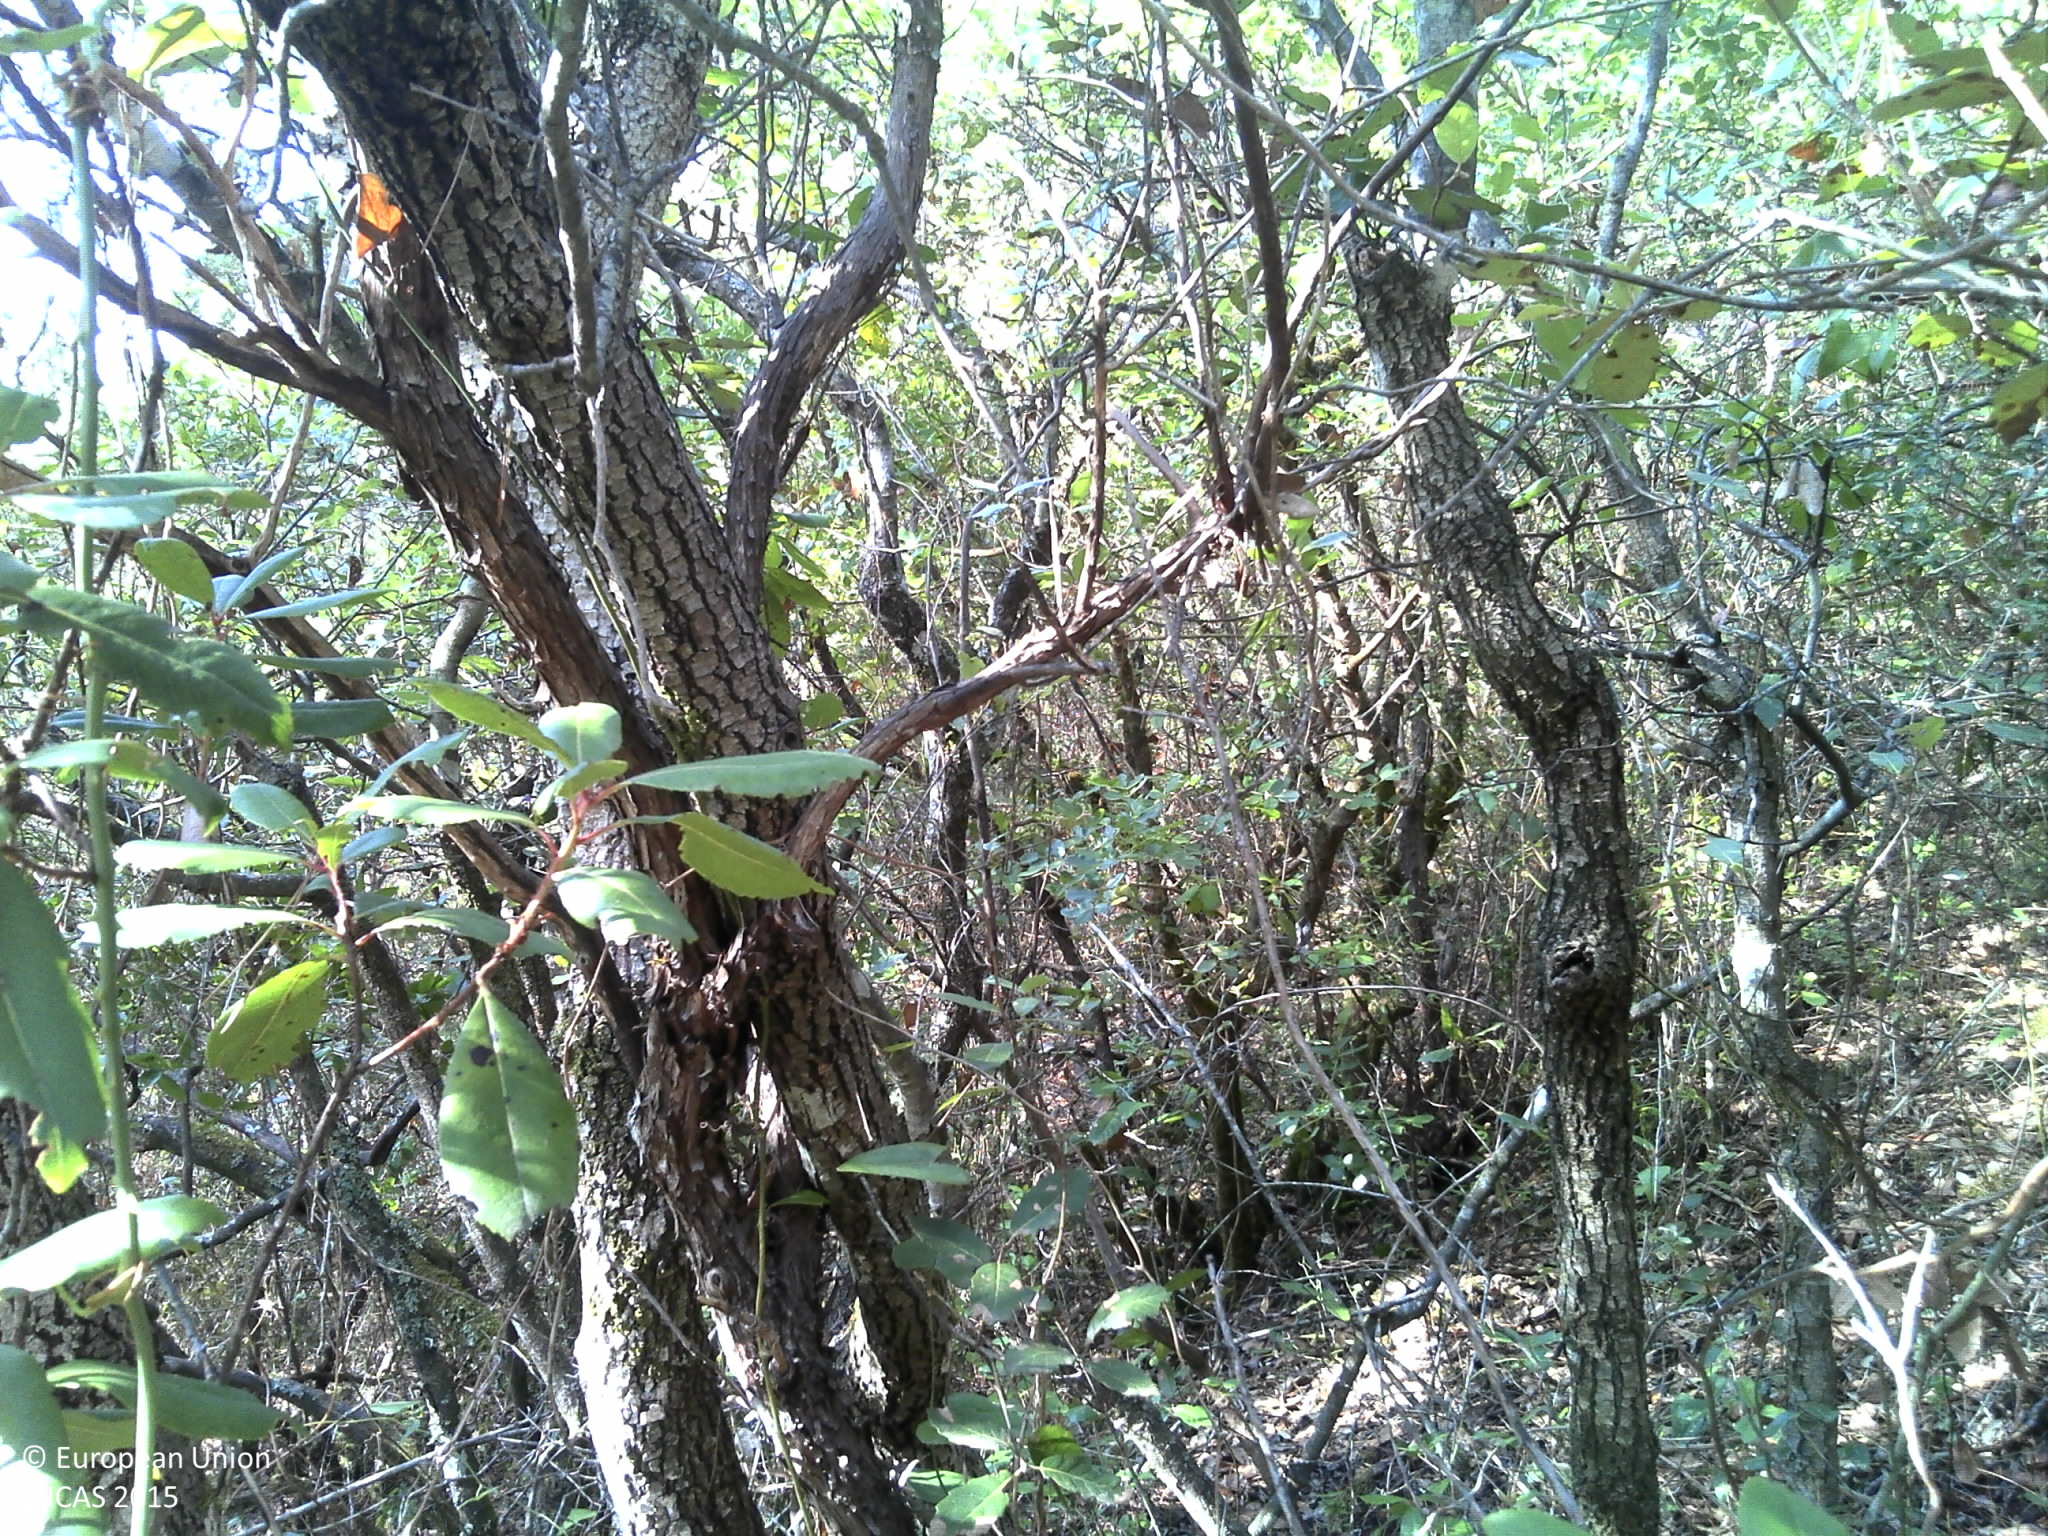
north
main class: Woodland
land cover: Pine dominated mixed woodland
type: coniferous forest of the mediterranean region
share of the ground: > 75 %
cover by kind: shrubs 50 %, coniferous forest trees 25 %, broadleaved forest trees 10 %, consolidated bare surface 10 %, lichens and mosses 5 %
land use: Semi-natural and natural areas not in use
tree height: > 5 m
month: August
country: HR
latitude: 43.1440
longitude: 16.8876
